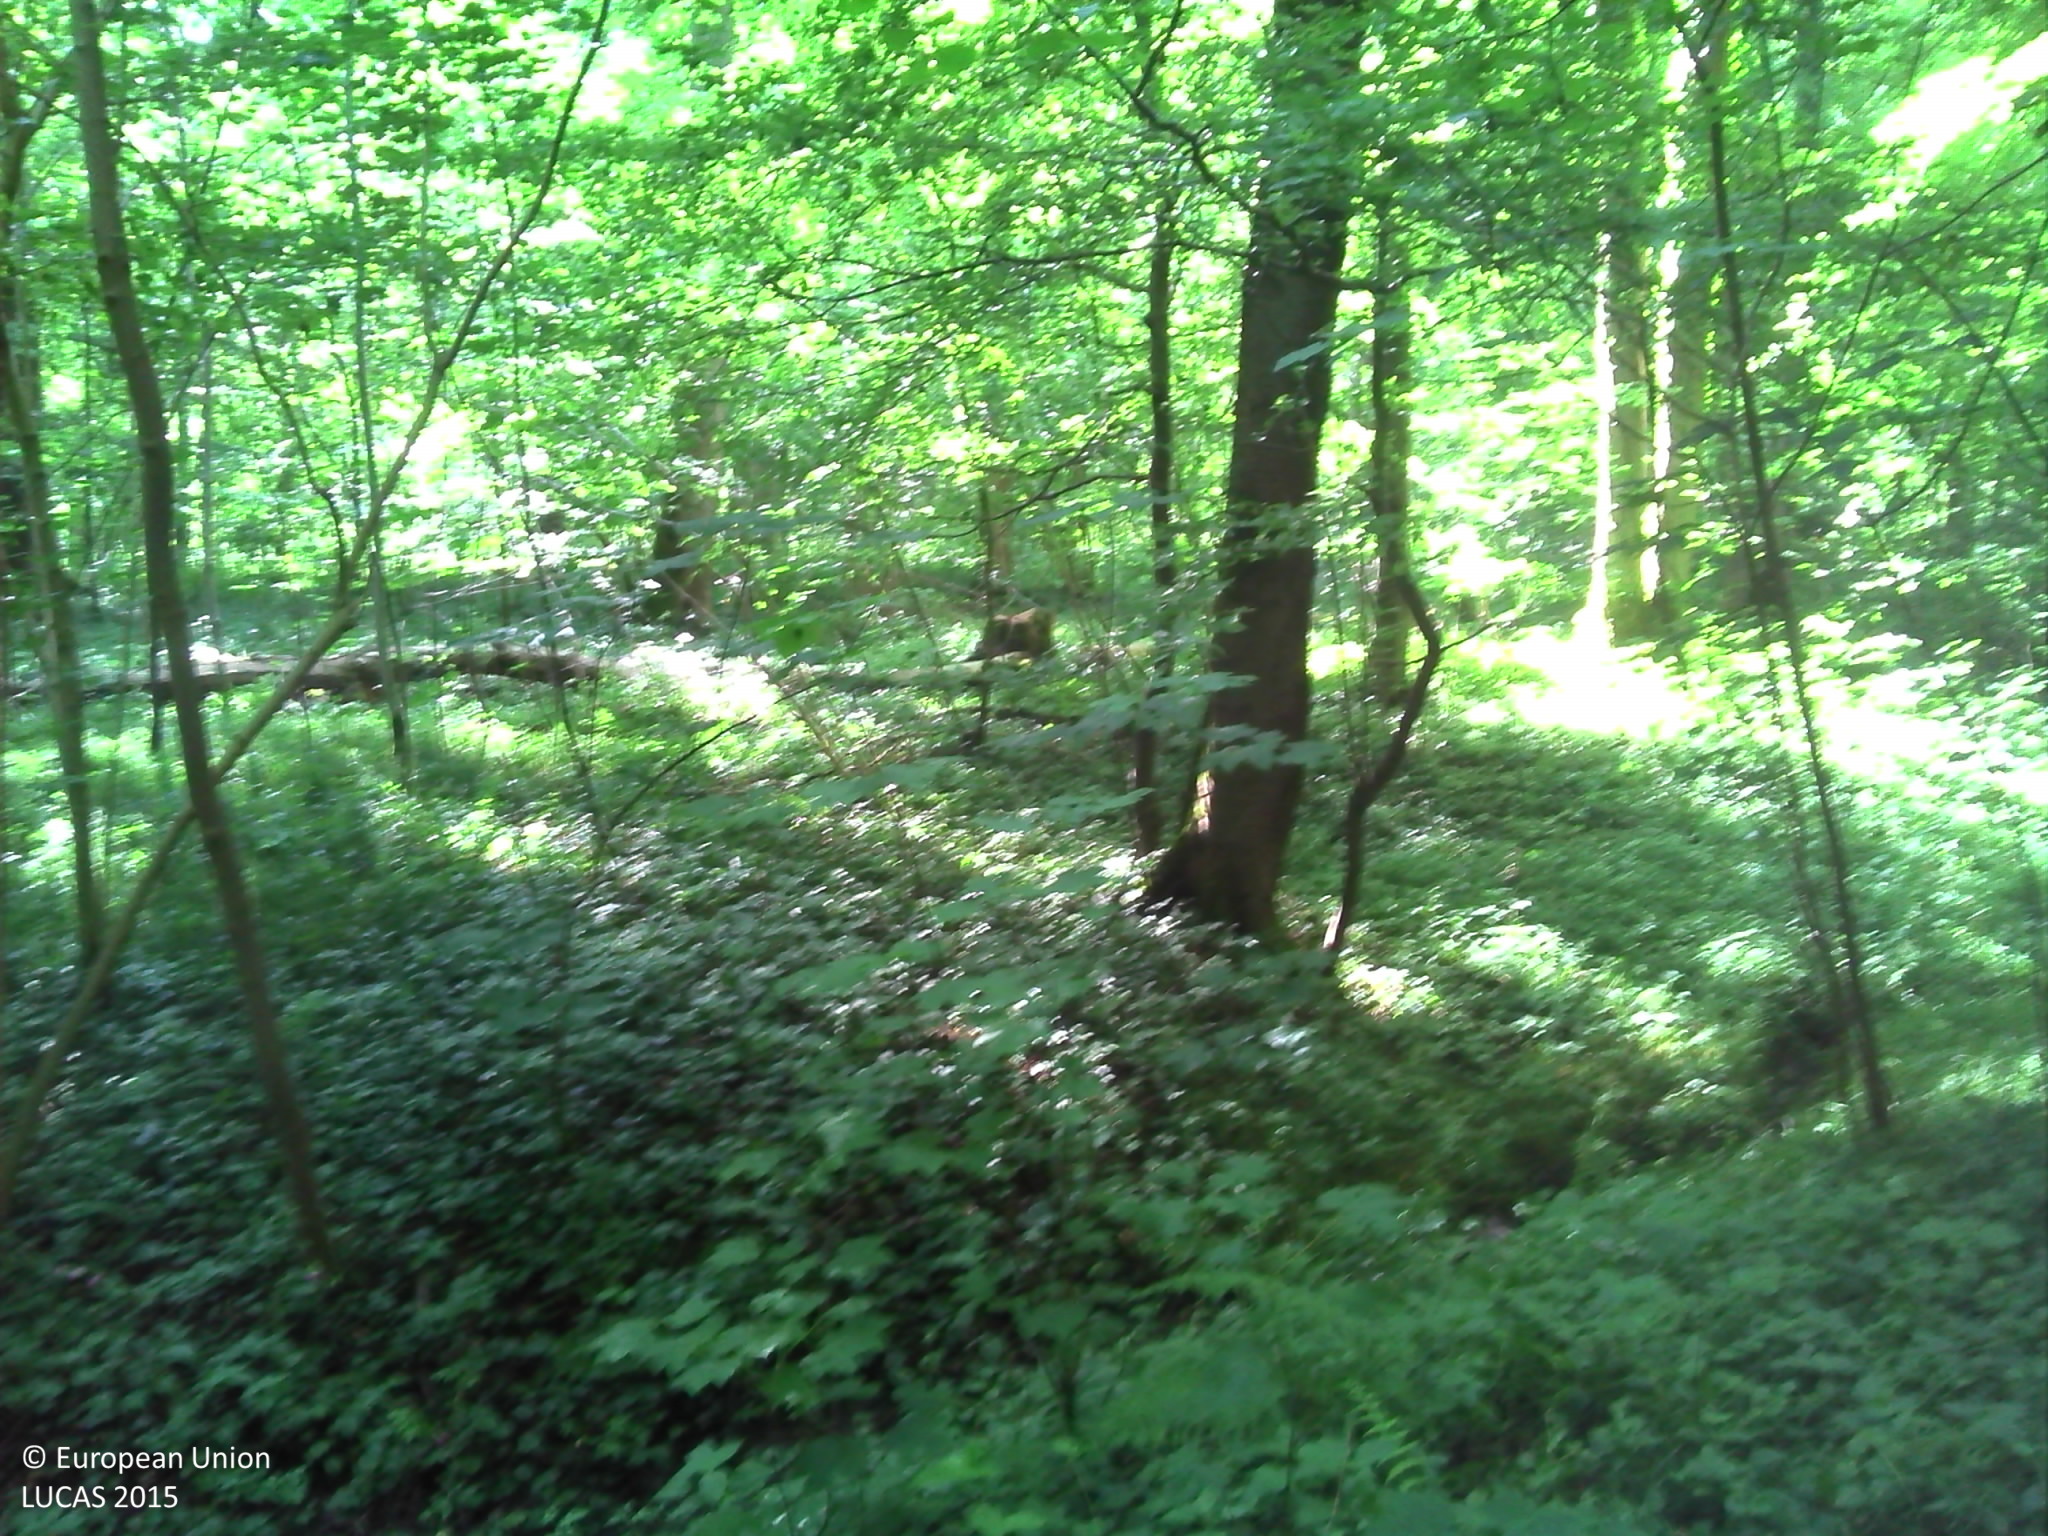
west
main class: Woodland
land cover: Broadleaved woodland
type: mesophytic deciduous forest
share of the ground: > 75 %
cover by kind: broadleaved forest trees 85 %, herbaceous plants 15 %
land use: Forestry
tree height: > 5 m
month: June
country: BE
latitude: 50.3788
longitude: 3.8485
